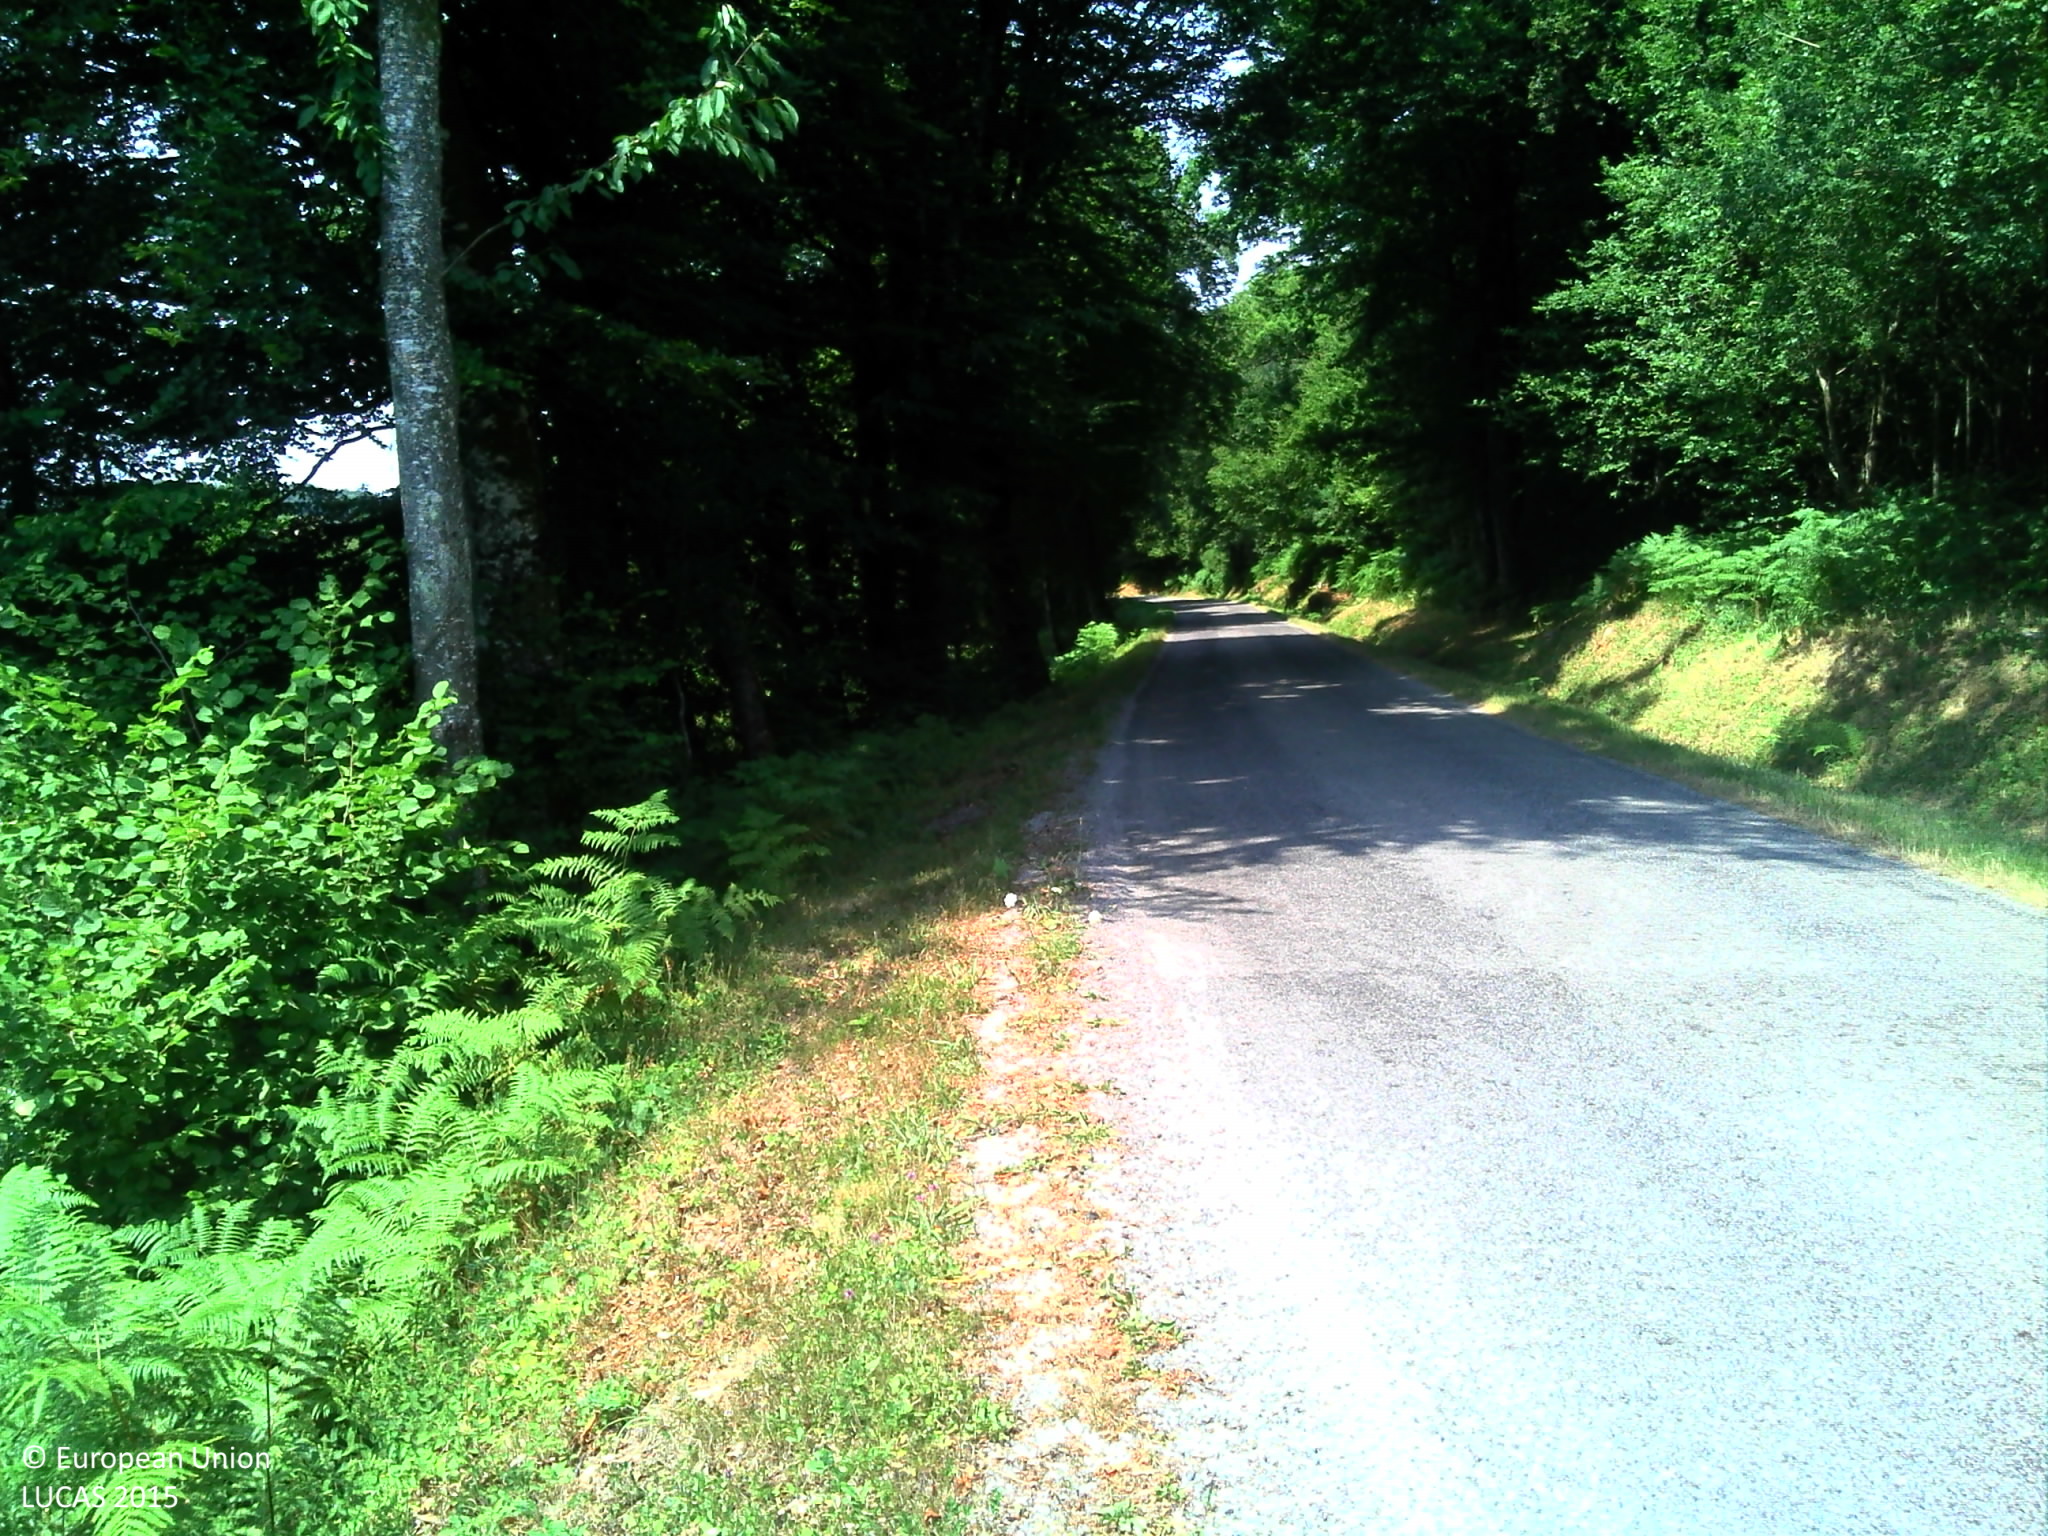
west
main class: Shrubland
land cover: Shrubland with sparse tree cover
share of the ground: > 75 %
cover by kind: shrubs 75 %, herbaceous plants 20 %, broadleaved forest trees 5 %
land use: Forestry
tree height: < 5 m
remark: Clear cut
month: July
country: FR
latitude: 46.0510
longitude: 1.7601
